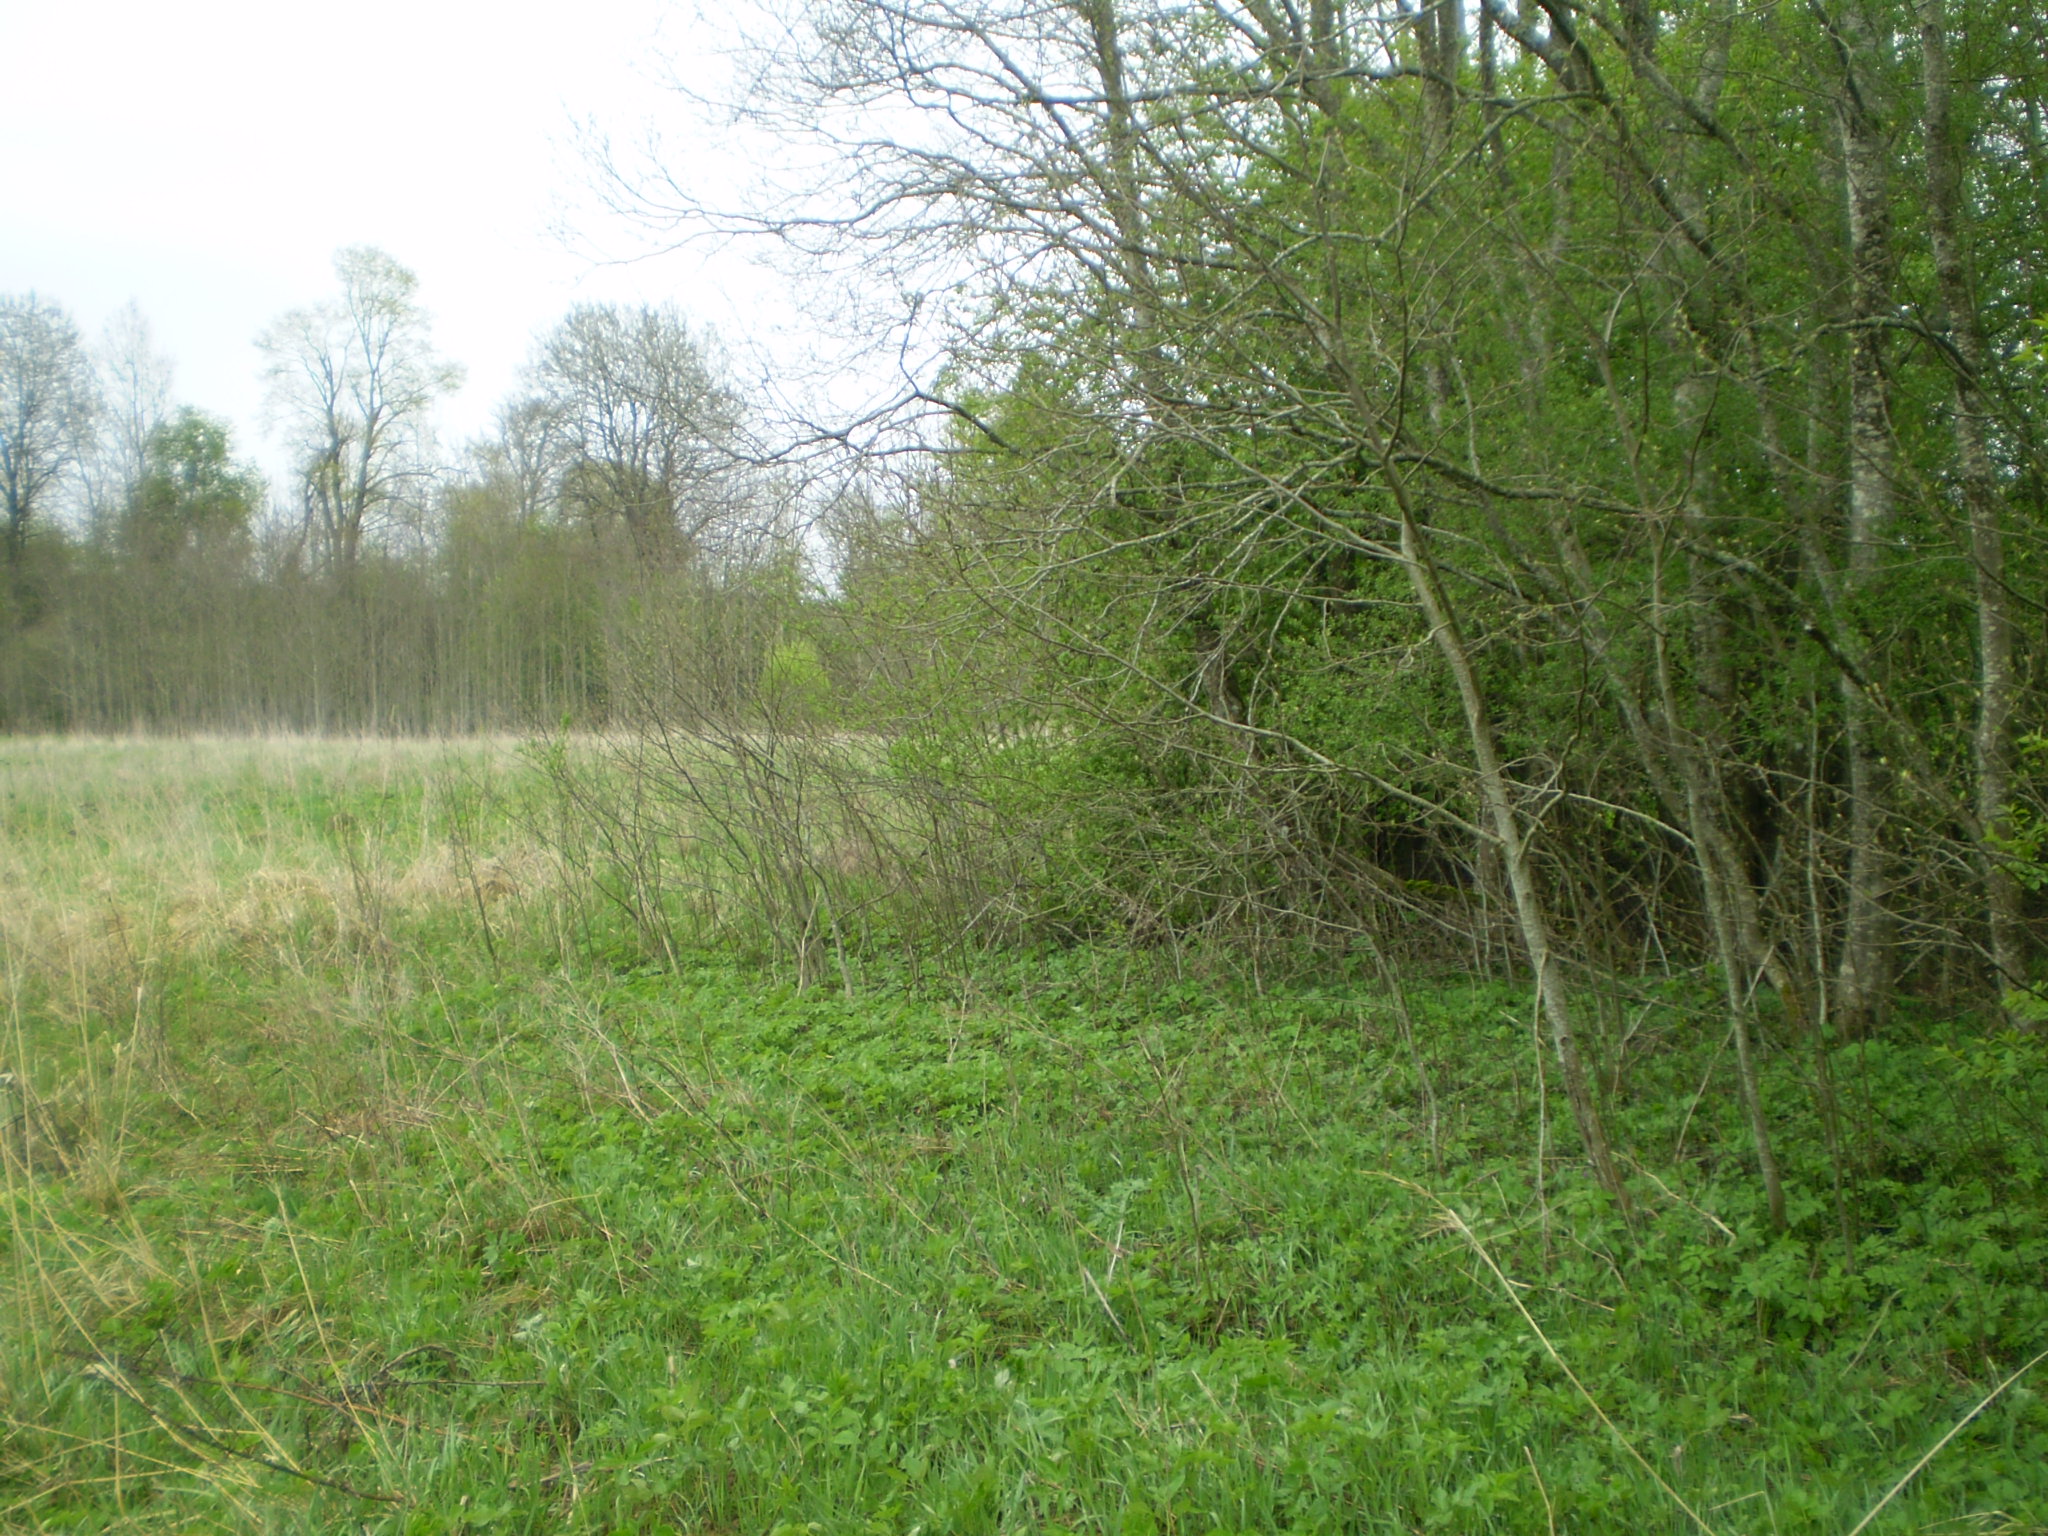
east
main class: Grassland
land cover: Spontaneously vegetated surfaces
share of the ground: > 75 %
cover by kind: herbaceous plants 100 %
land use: Abandoned areas
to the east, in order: Spontaneously vegetated surfaces; Broadleaved woodland; Grassland without tree/shrub cover; Grassland with sparse tree/shrub cover; Other mixed woodland; Spontaneously vegetated surfaces; Other mixed woodland; Grassland without tree/shrub cover; Single bushes/trees; Grass margins; Paved roads, cycling and walking lanes; Electric lines; Shruby margins; Grassland without tree/shrub cover
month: May
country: LT
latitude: 56.3198
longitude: 22.1301
